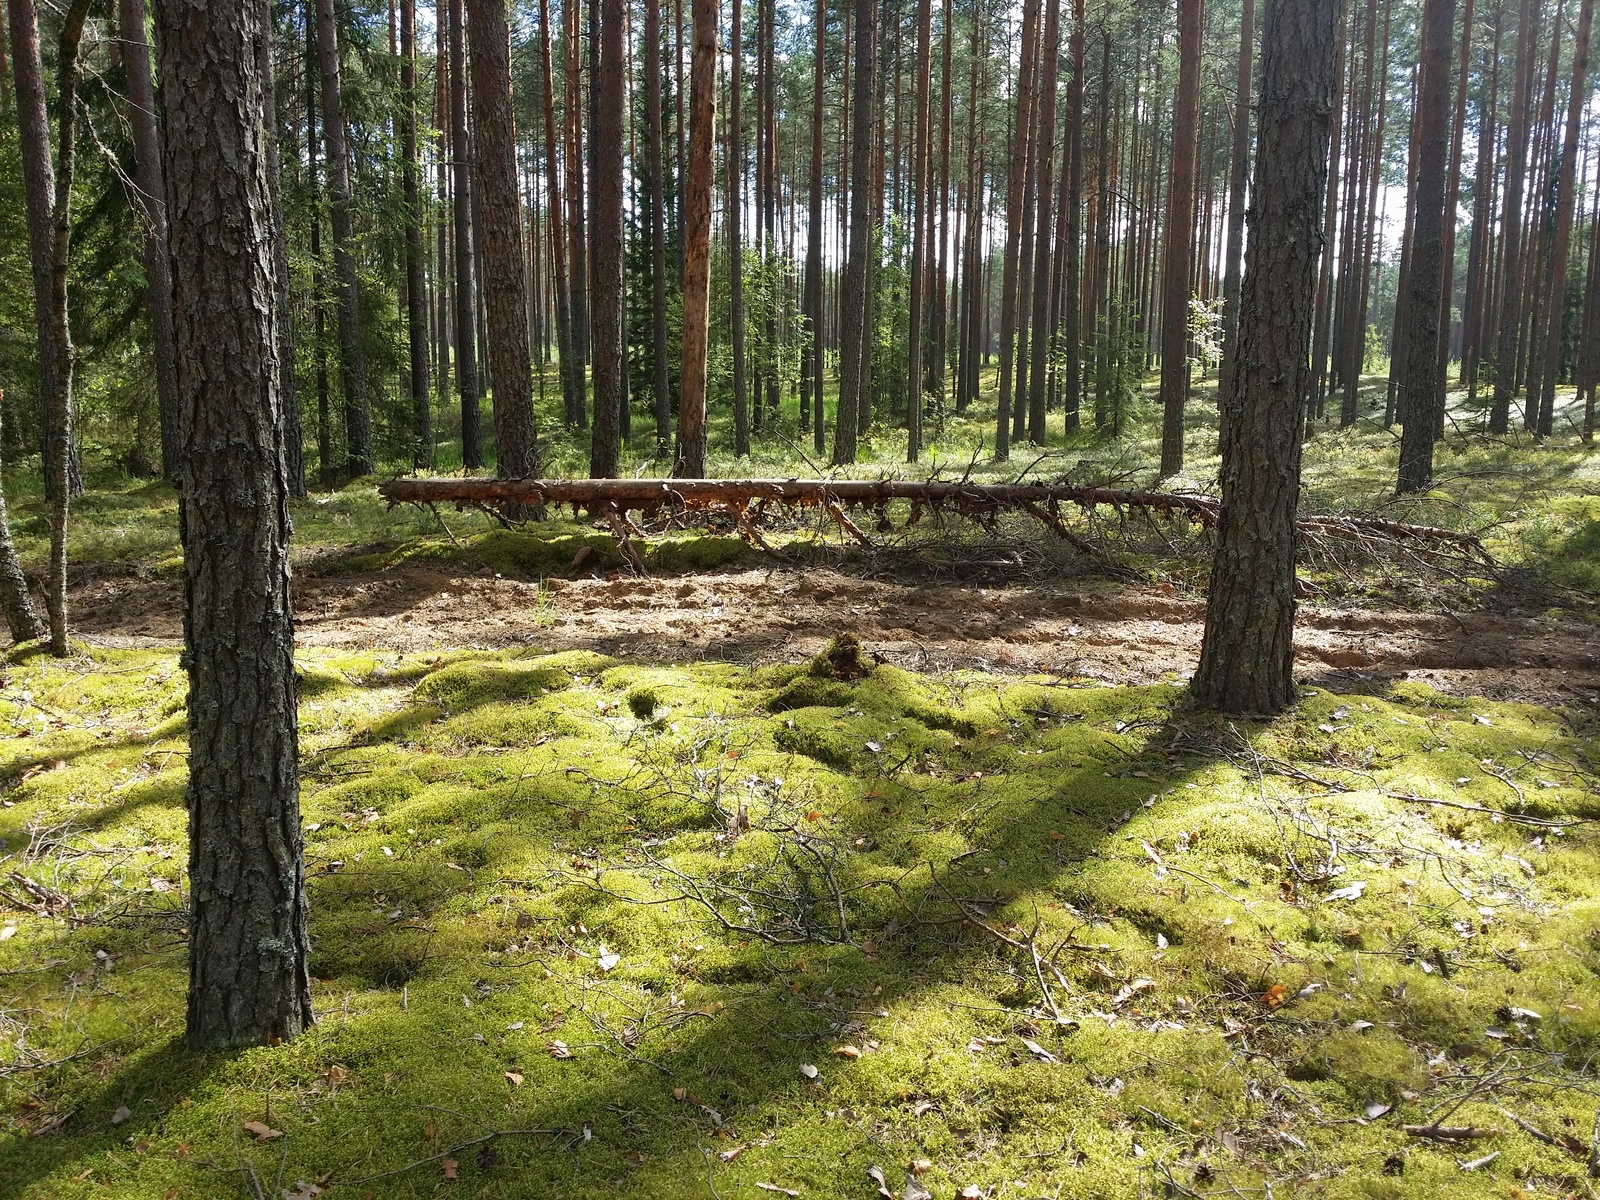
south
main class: Woodland
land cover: Pine dominated coniferous woodland
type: hemiboreal forest and nemoral coniferous forest and mixed broadleaved-coniferous forest
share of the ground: 50 - 75 %
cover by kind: coniferous forest trees 70 %, lichens and mosses 30 %
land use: Forestry
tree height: > 5 m
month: August
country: LV
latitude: 57.3466
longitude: 27.6791
